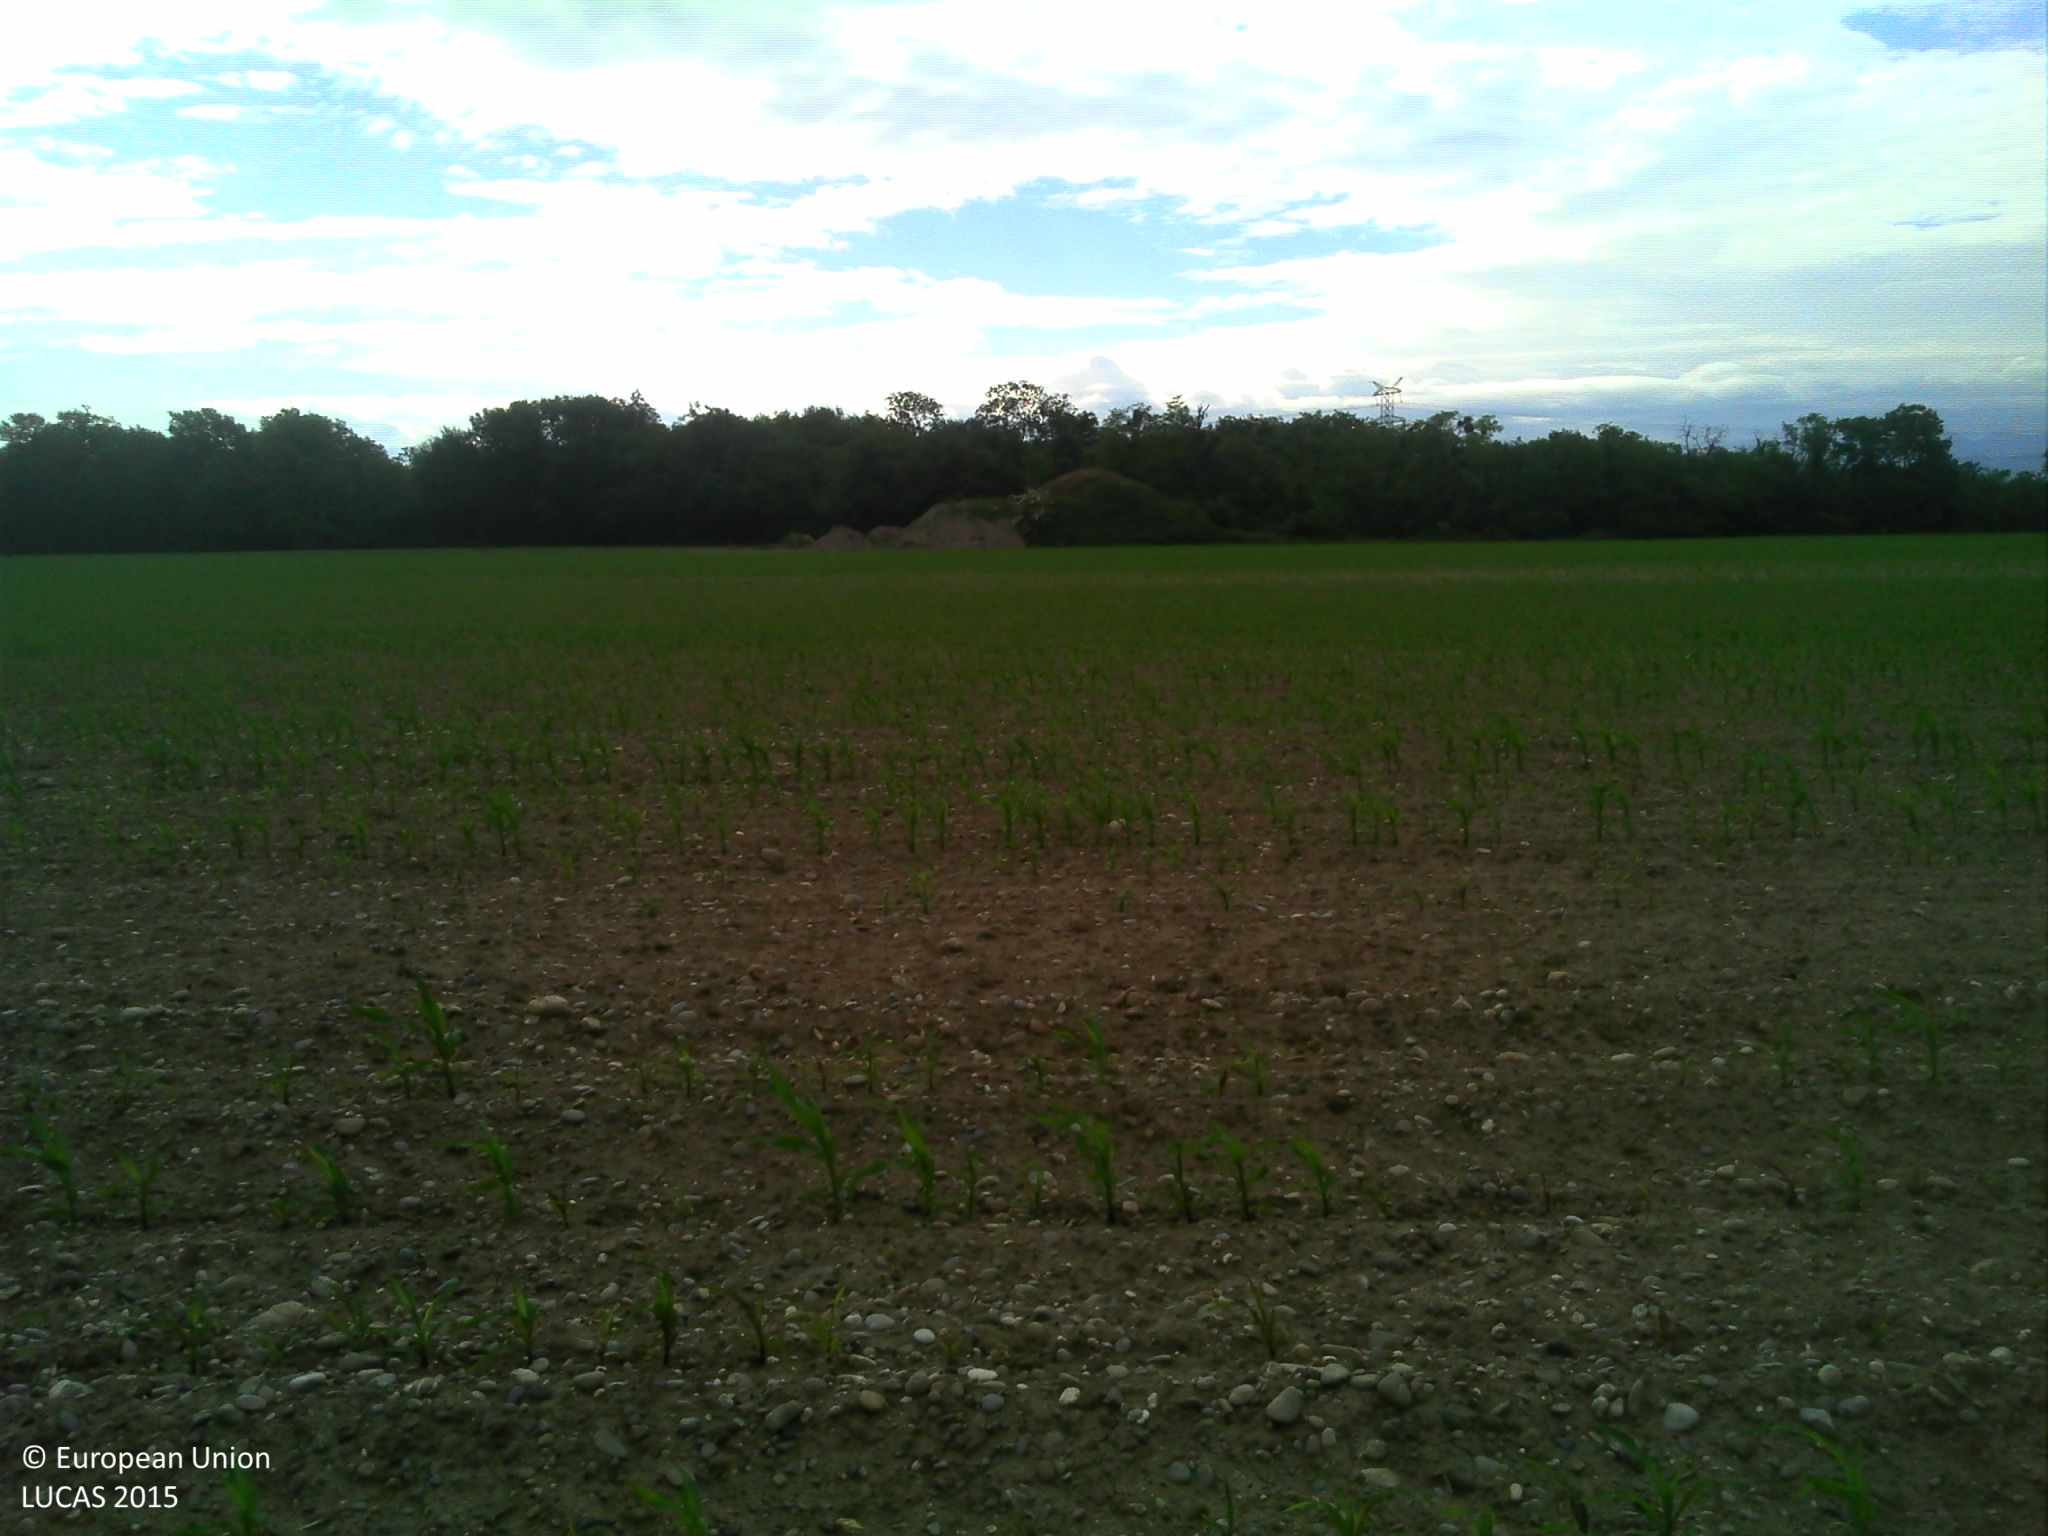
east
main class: Cropland
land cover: Maize
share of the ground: < 10 %
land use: Agriculture (excluding fallow land and kitchen gardens)
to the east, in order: Maize; Grass margins; Tracks; Grass margins; Maize
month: June
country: FR
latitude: 47.9815
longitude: 7.6030
